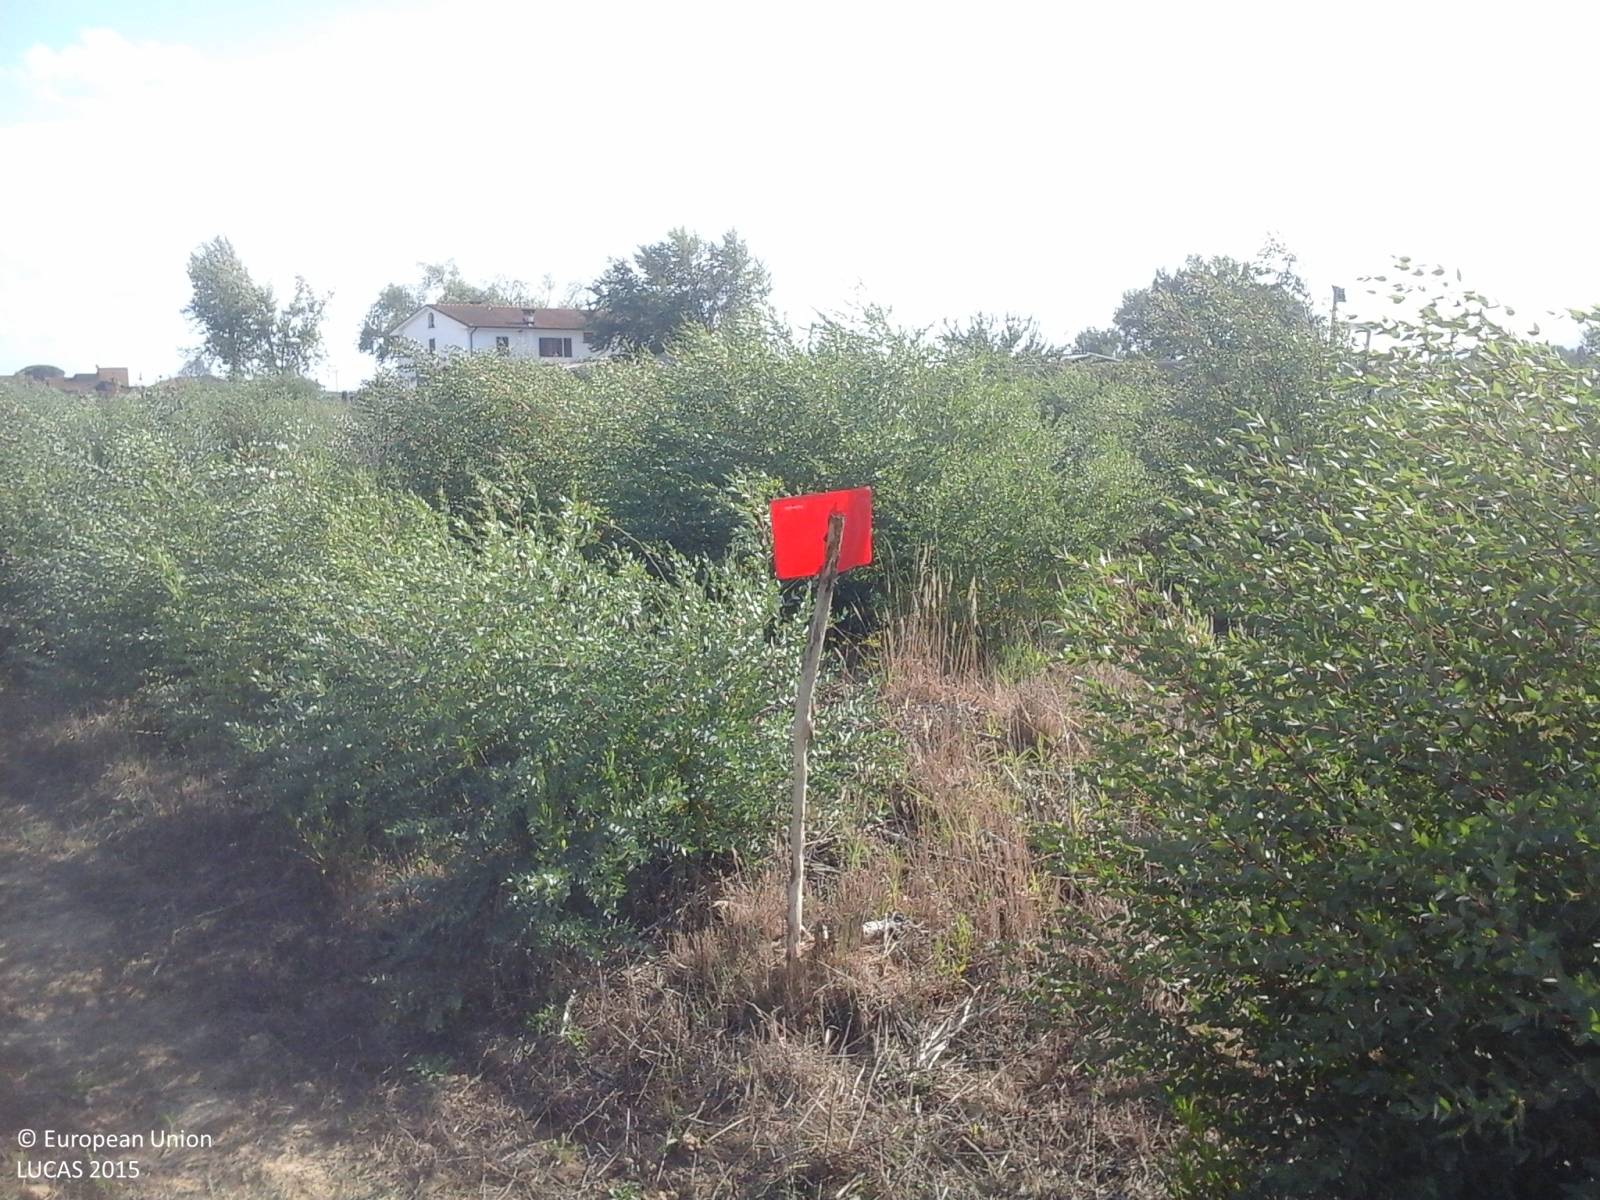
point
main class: Cropland
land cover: Nurseries
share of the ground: > 75 %
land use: Agriculture (excluding fallow land and kitchen gardens)
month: August
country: IT
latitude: 43.8069
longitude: 10.7067
